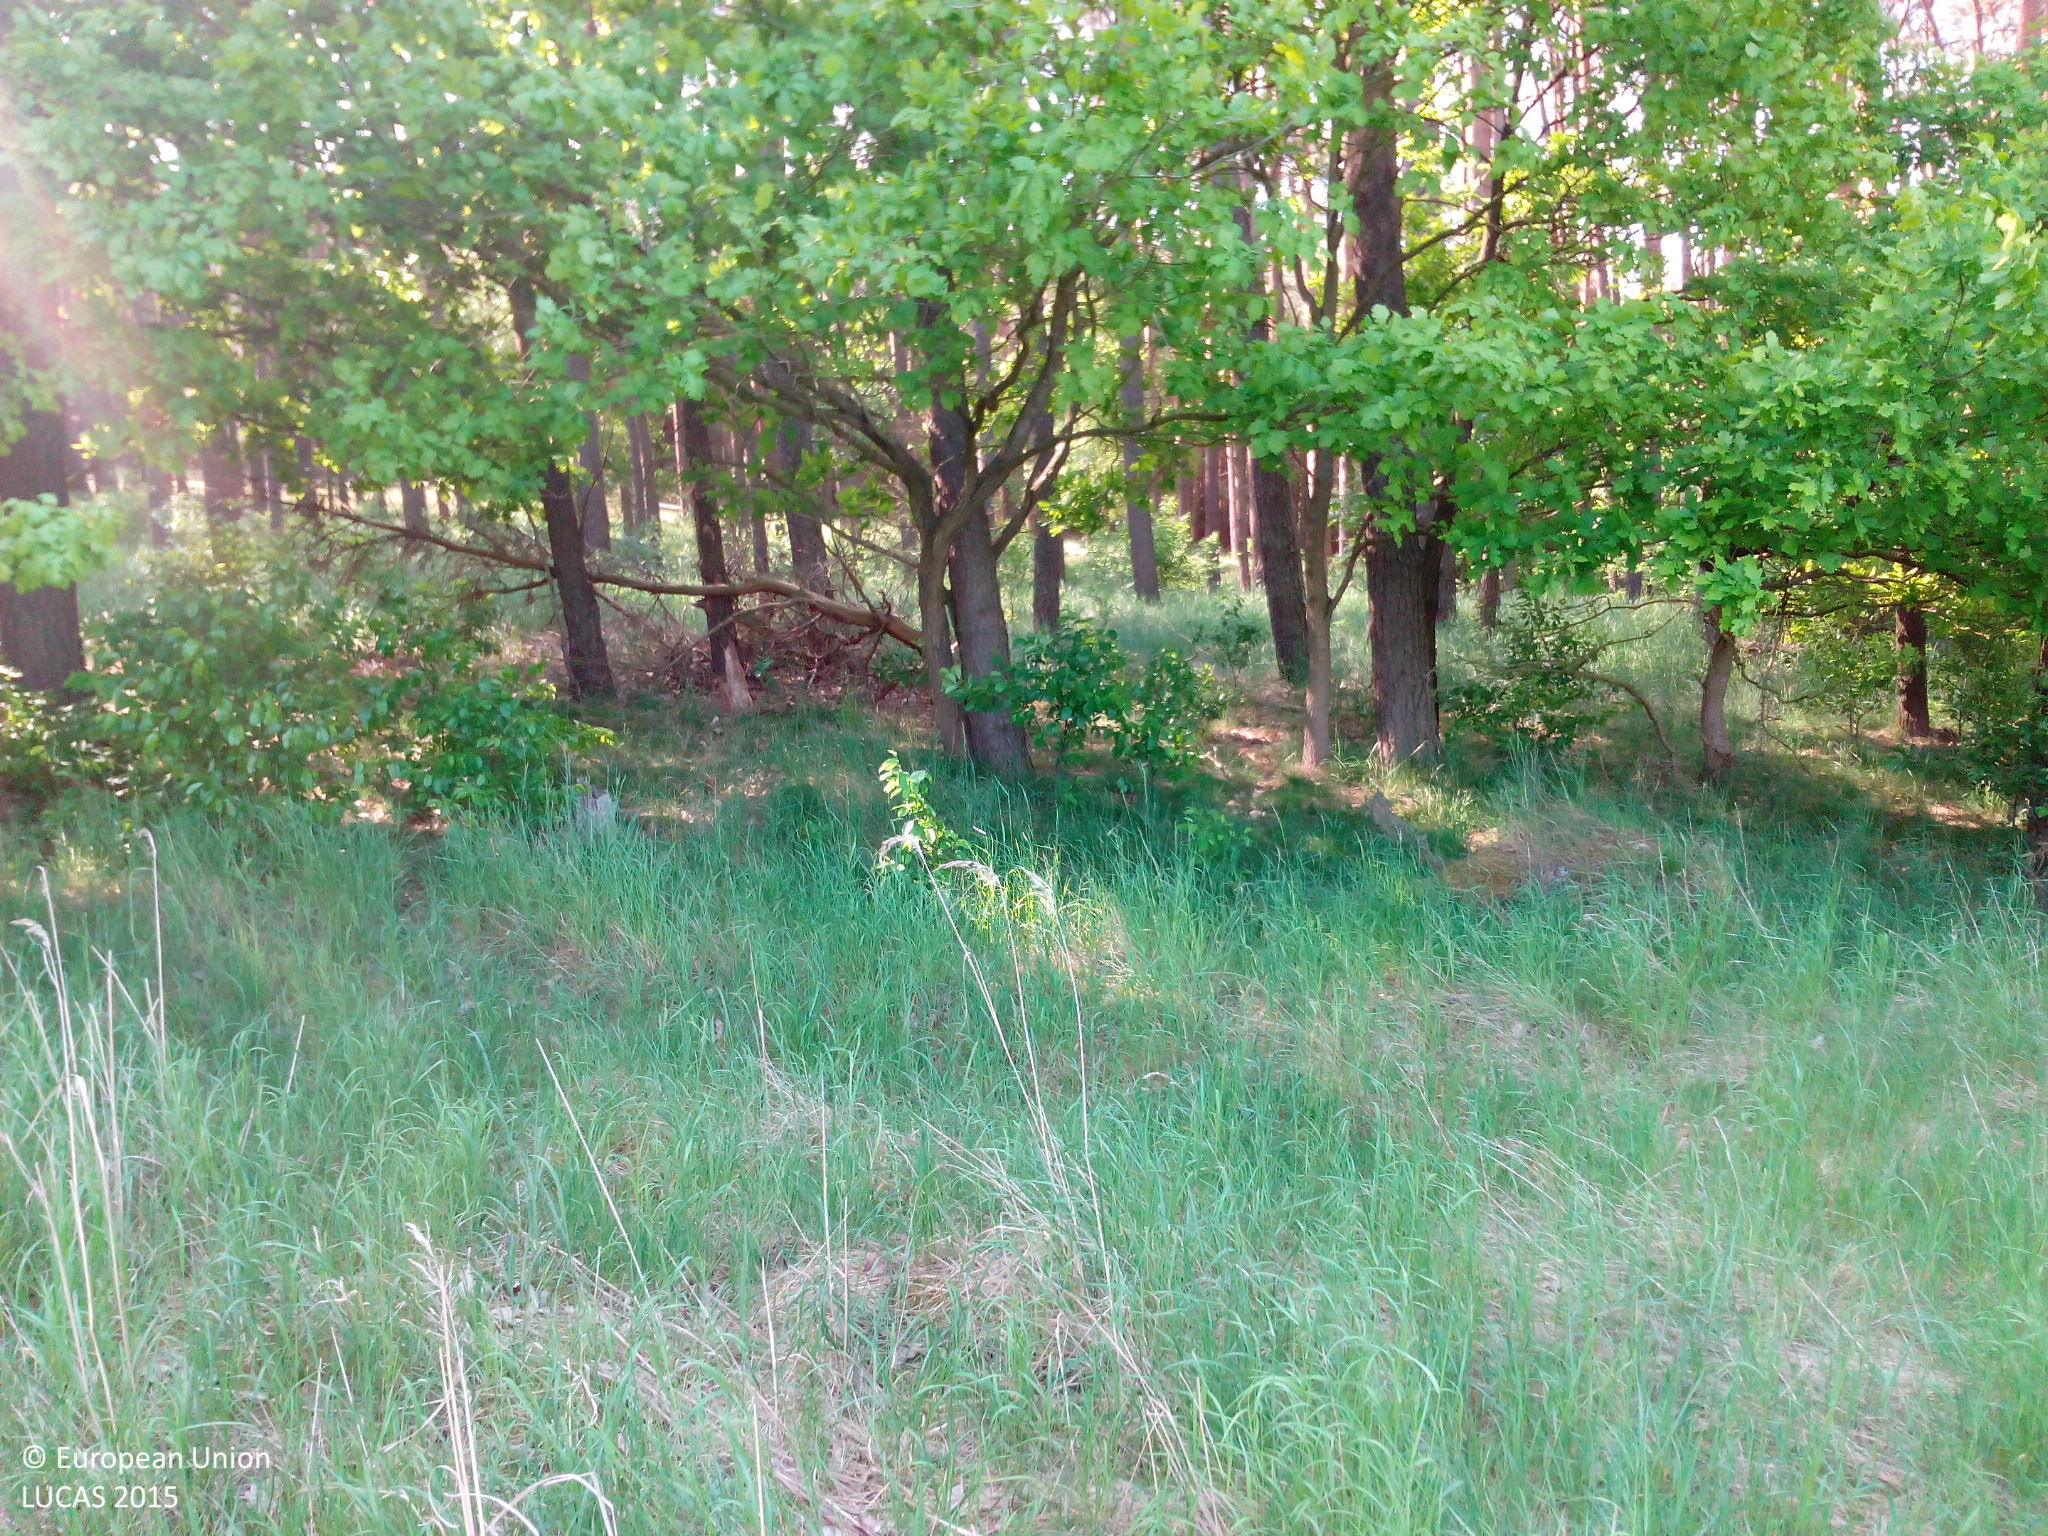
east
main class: Grassland
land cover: Grassland without tree/shrub cover
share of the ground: > 75 %
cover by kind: herbaceous plants 100 %
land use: Agriculture (excluding fallow land and kitchen gardens)
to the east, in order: Grassland without tree/shrub cover; Pine dominated coniferous woodland
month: May
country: DE
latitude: 52.0303
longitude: 13.1338
